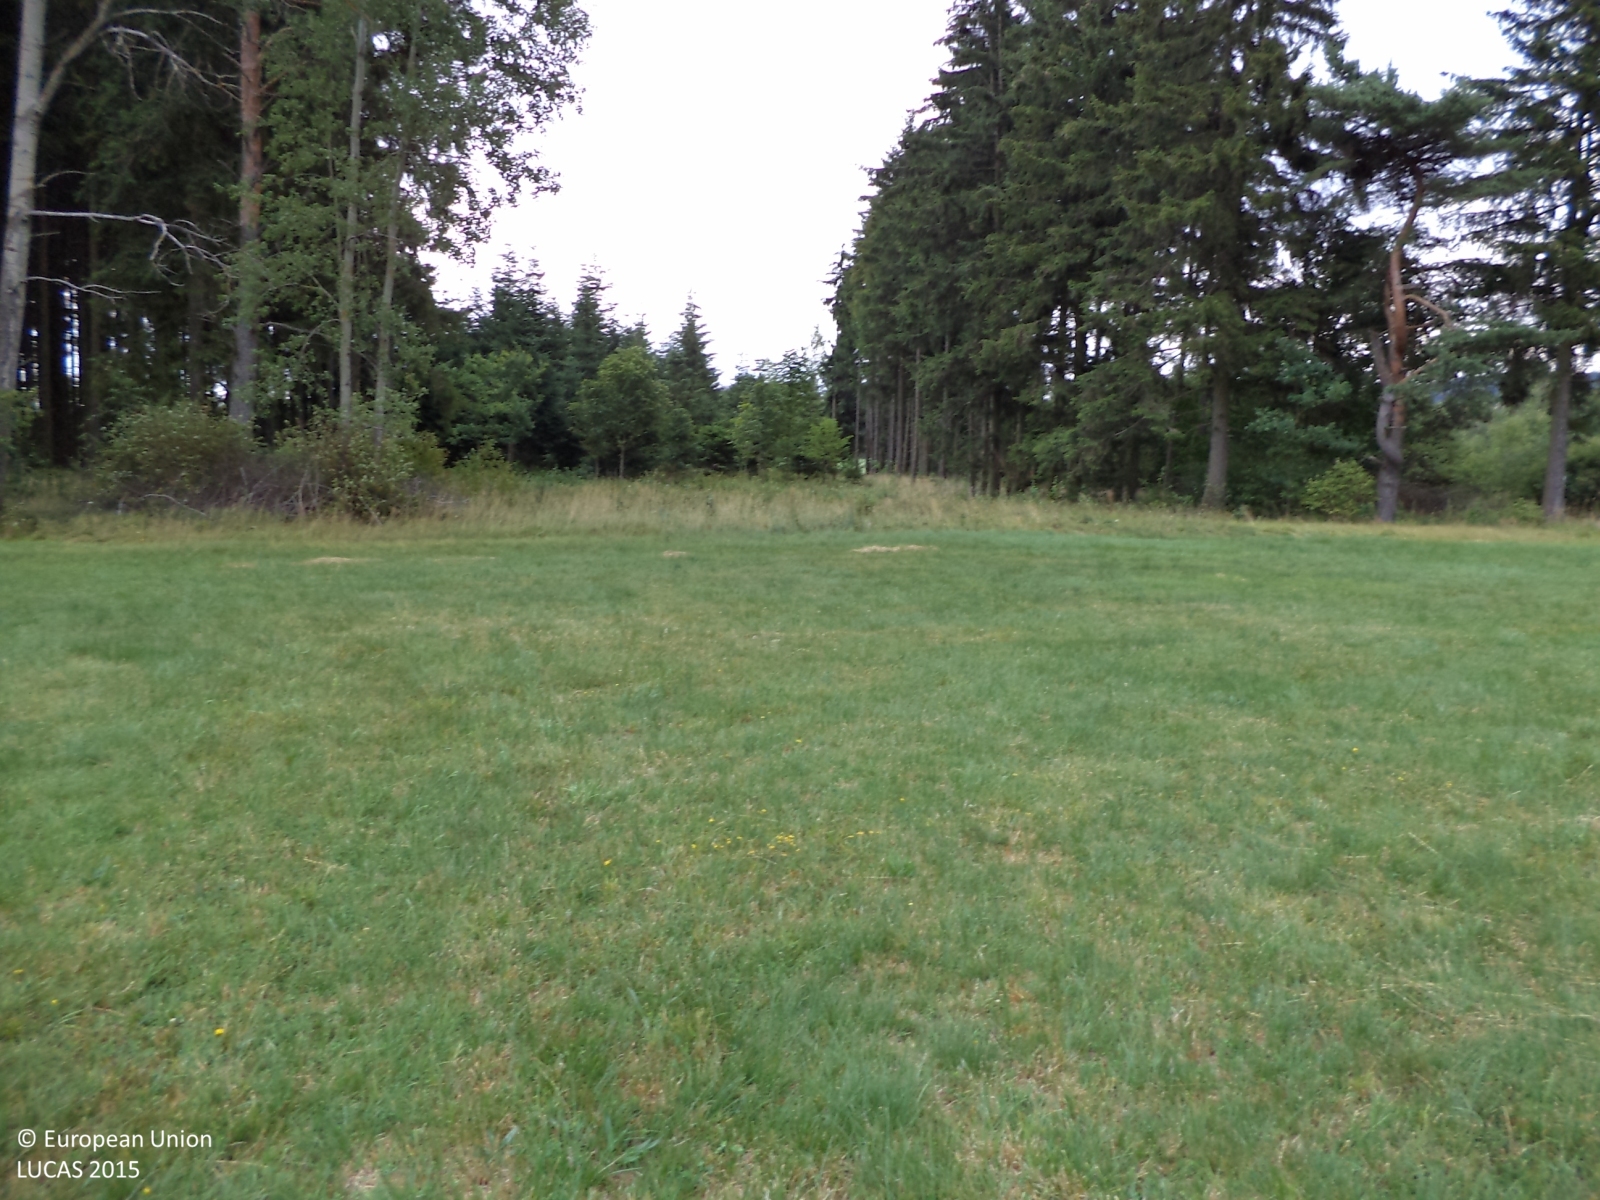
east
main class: Grassland
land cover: Grassland without tree/shrub cover
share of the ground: > 75 %
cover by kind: herbaceous plants 100 %
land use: Agriculture (excluding fallow land and kitchen gardens)
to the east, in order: Grassland without tree/shrub cover; Other mixed woodland; Spruce dominated mixed woodland; Shrubland without tree cover; Ditches and canals; Tracks; Grassland without tree/shrub cover
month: July
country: CZ
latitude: 49.5987
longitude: 13.8054
